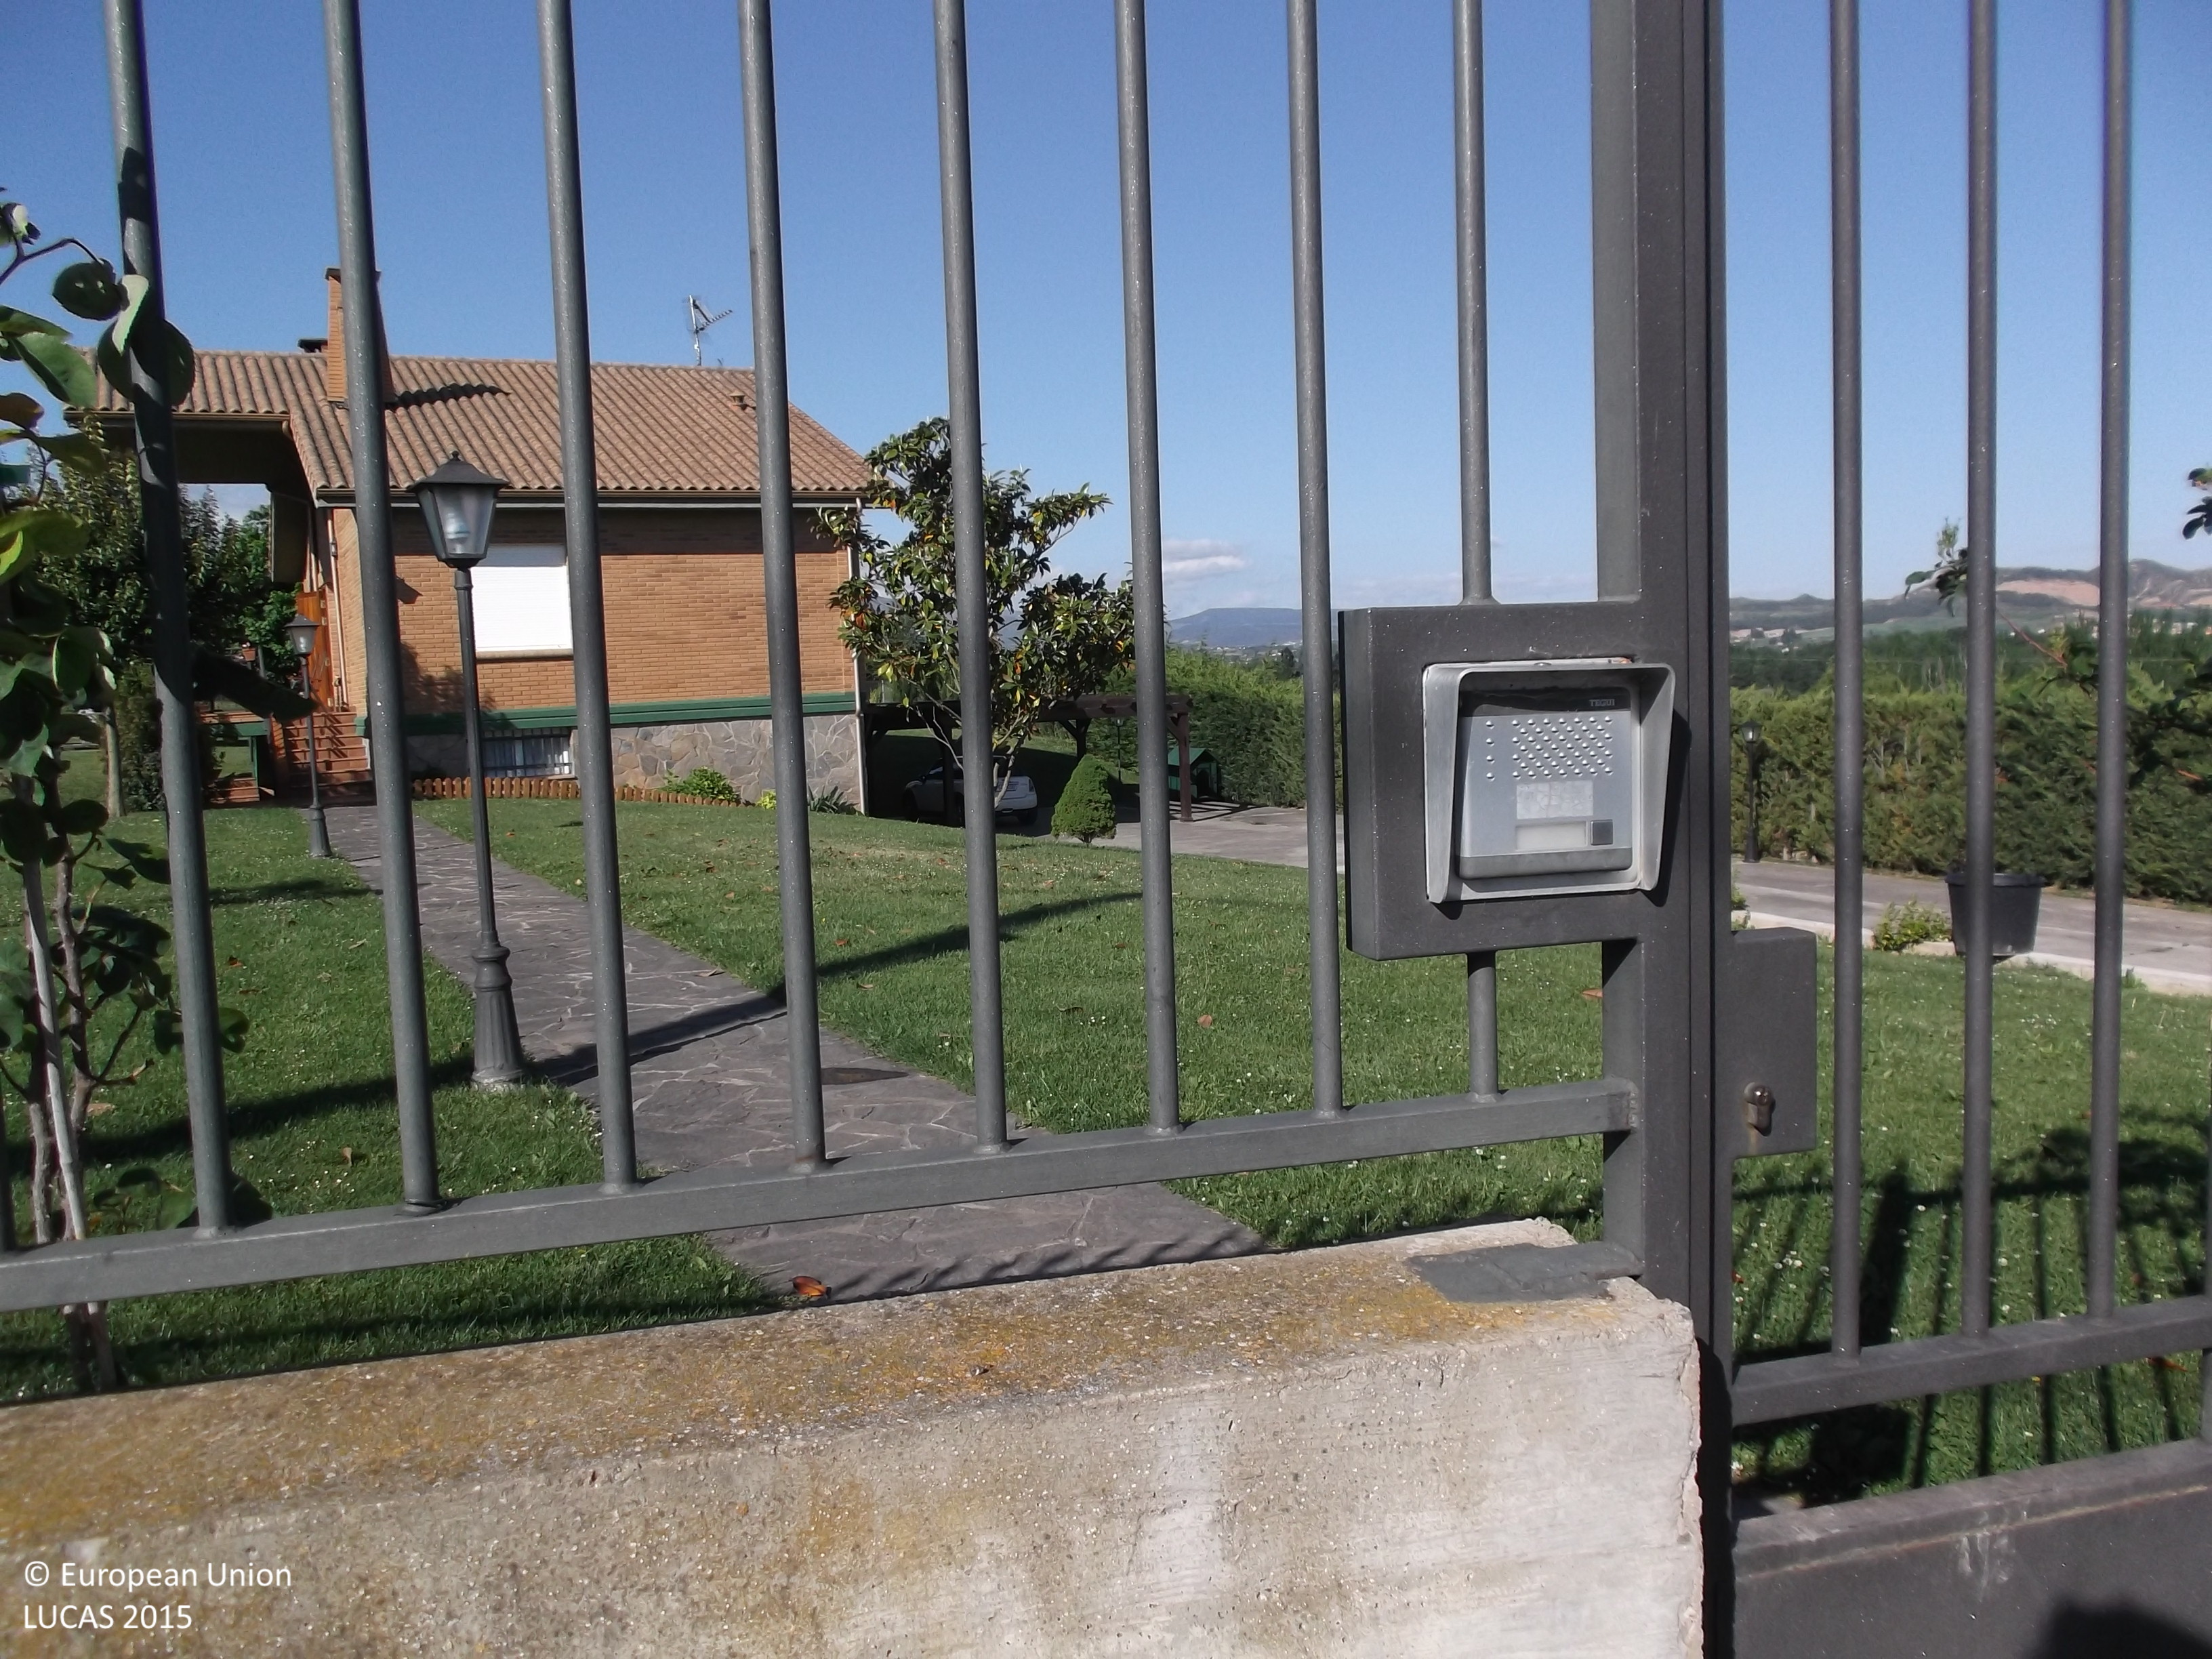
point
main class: Grassland
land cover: Grassland without tree/shrub cover
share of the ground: > 75 %
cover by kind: herbaceous plants 100 %
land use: Residential
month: May
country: ES
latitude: 42.4148
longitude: -2.4270
